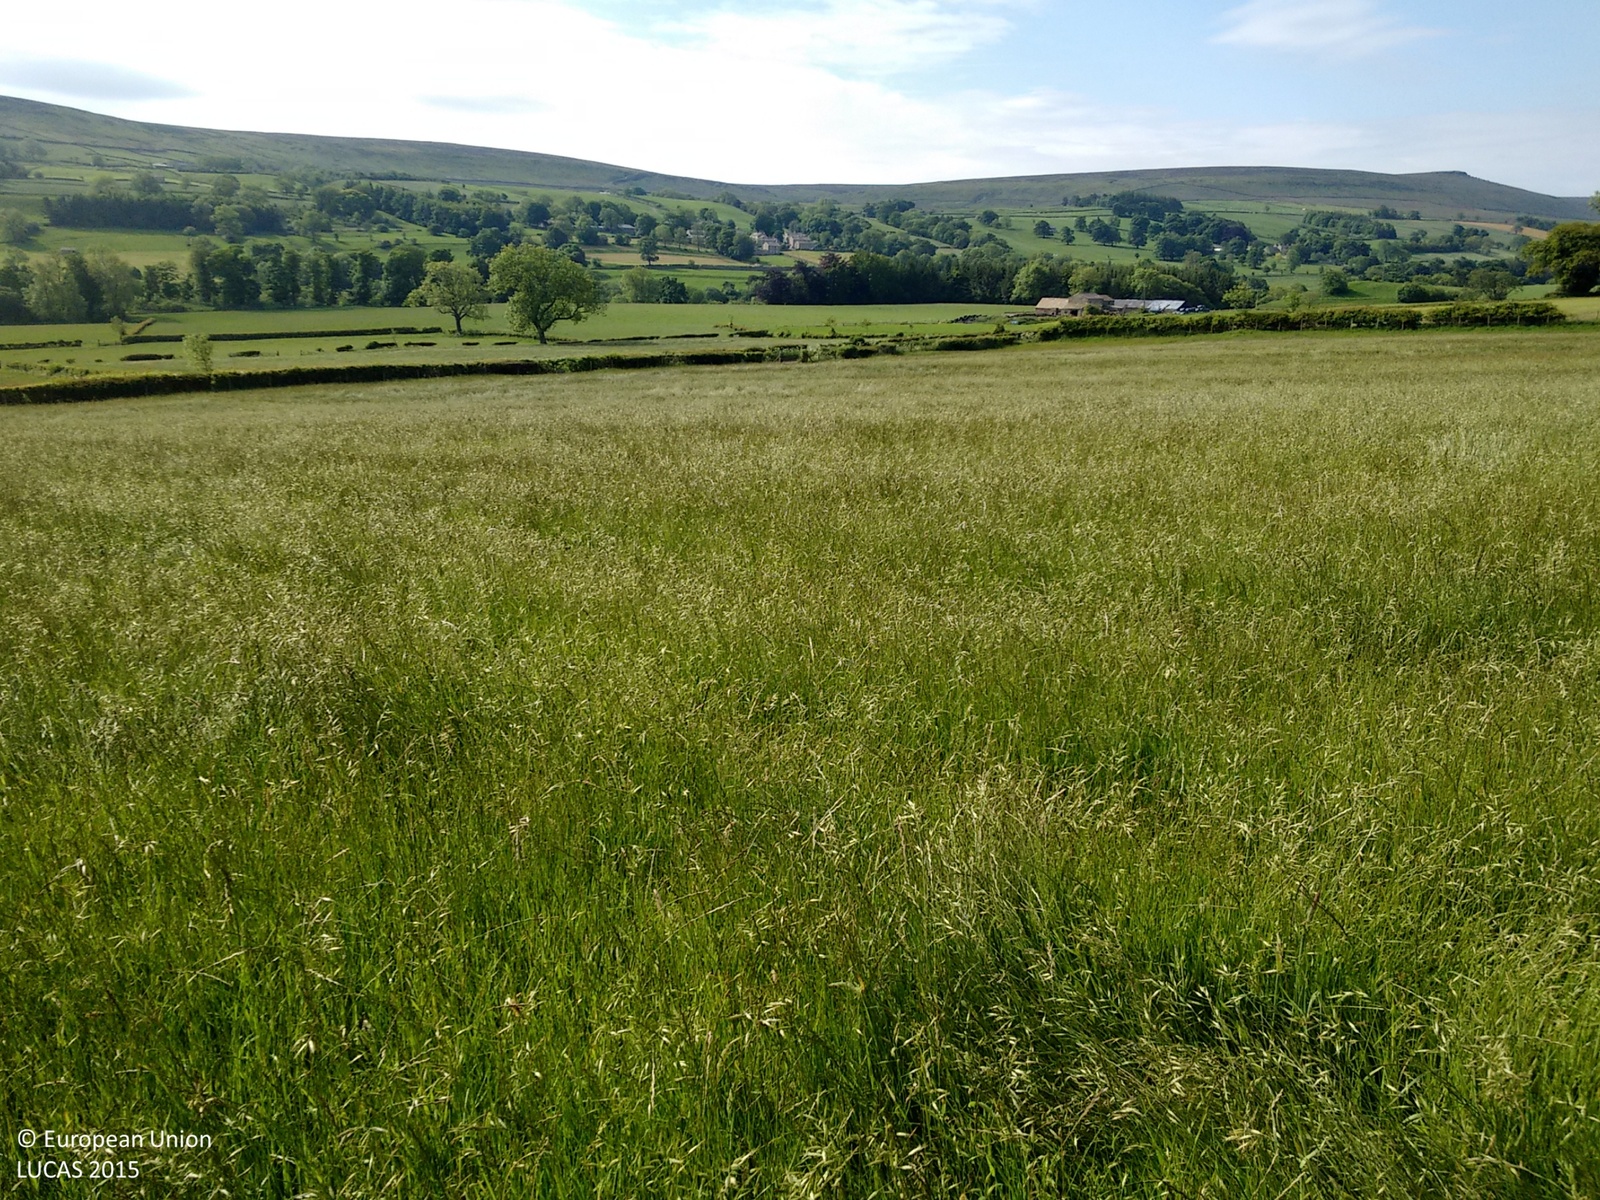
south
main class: Grassland
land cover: Grassland without tree/shrub cover
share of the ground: > 75 %
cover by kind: herbaceous plants 100 %
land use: Agriculture (excluding fallow land and kitchen gardens)
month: June
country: GB
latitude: 54.2710
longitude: -1.8626
